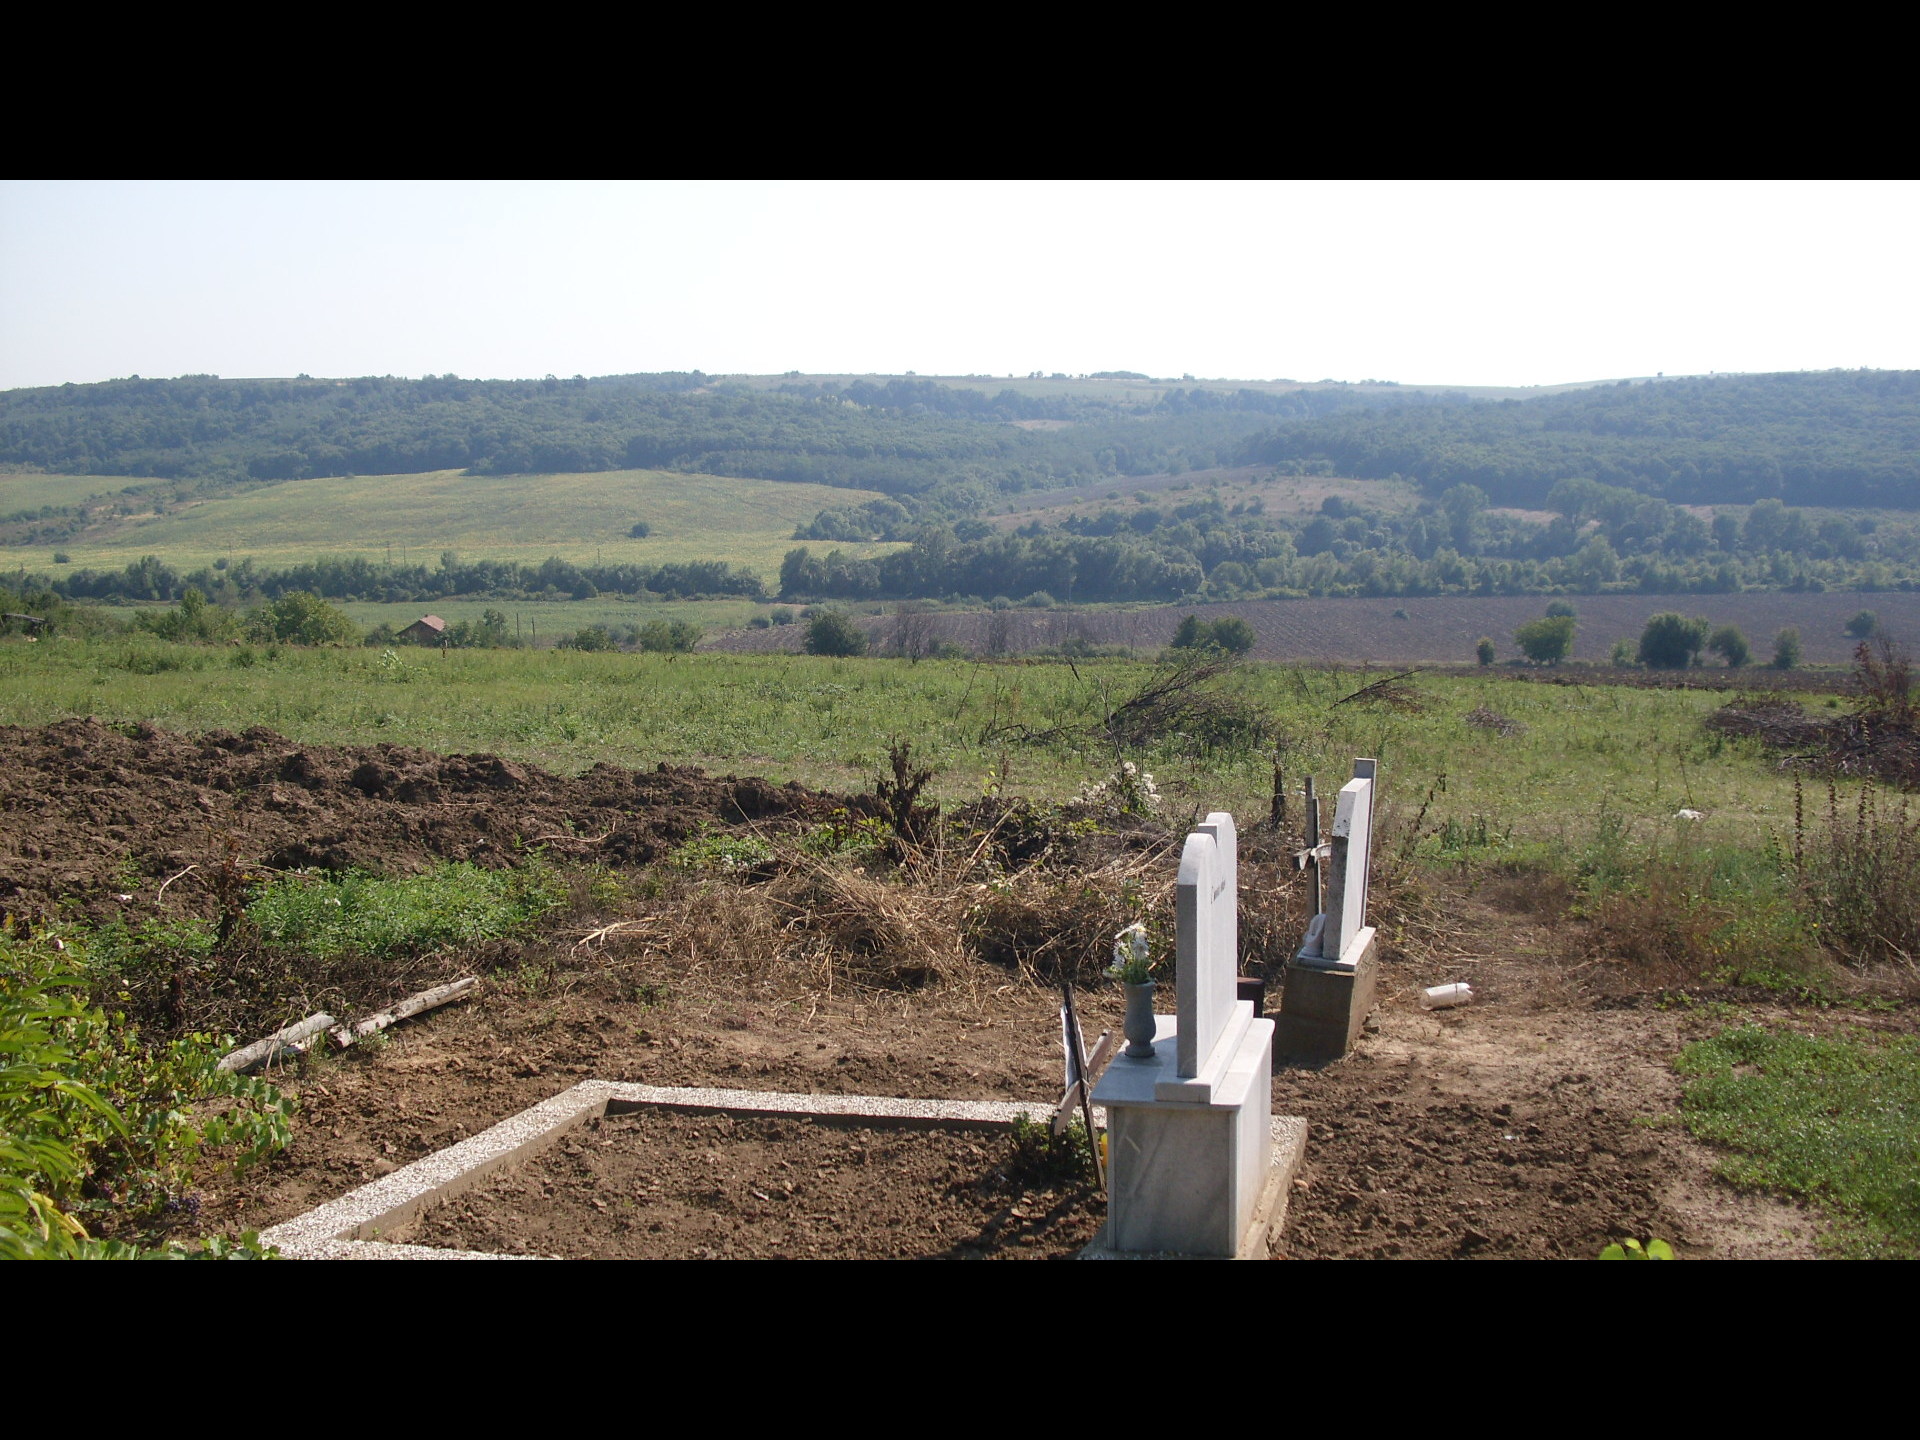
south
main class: Shrubland
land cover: Shrubland with sparse tree cover
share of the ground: > 75 %
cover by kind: shrubs 80 %, herbaceous plants 15 %, broadleaved forest trees 5 %
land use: Community services
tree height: < 5 m
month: August
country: BG
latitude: 44.0698
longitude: 22.7614
